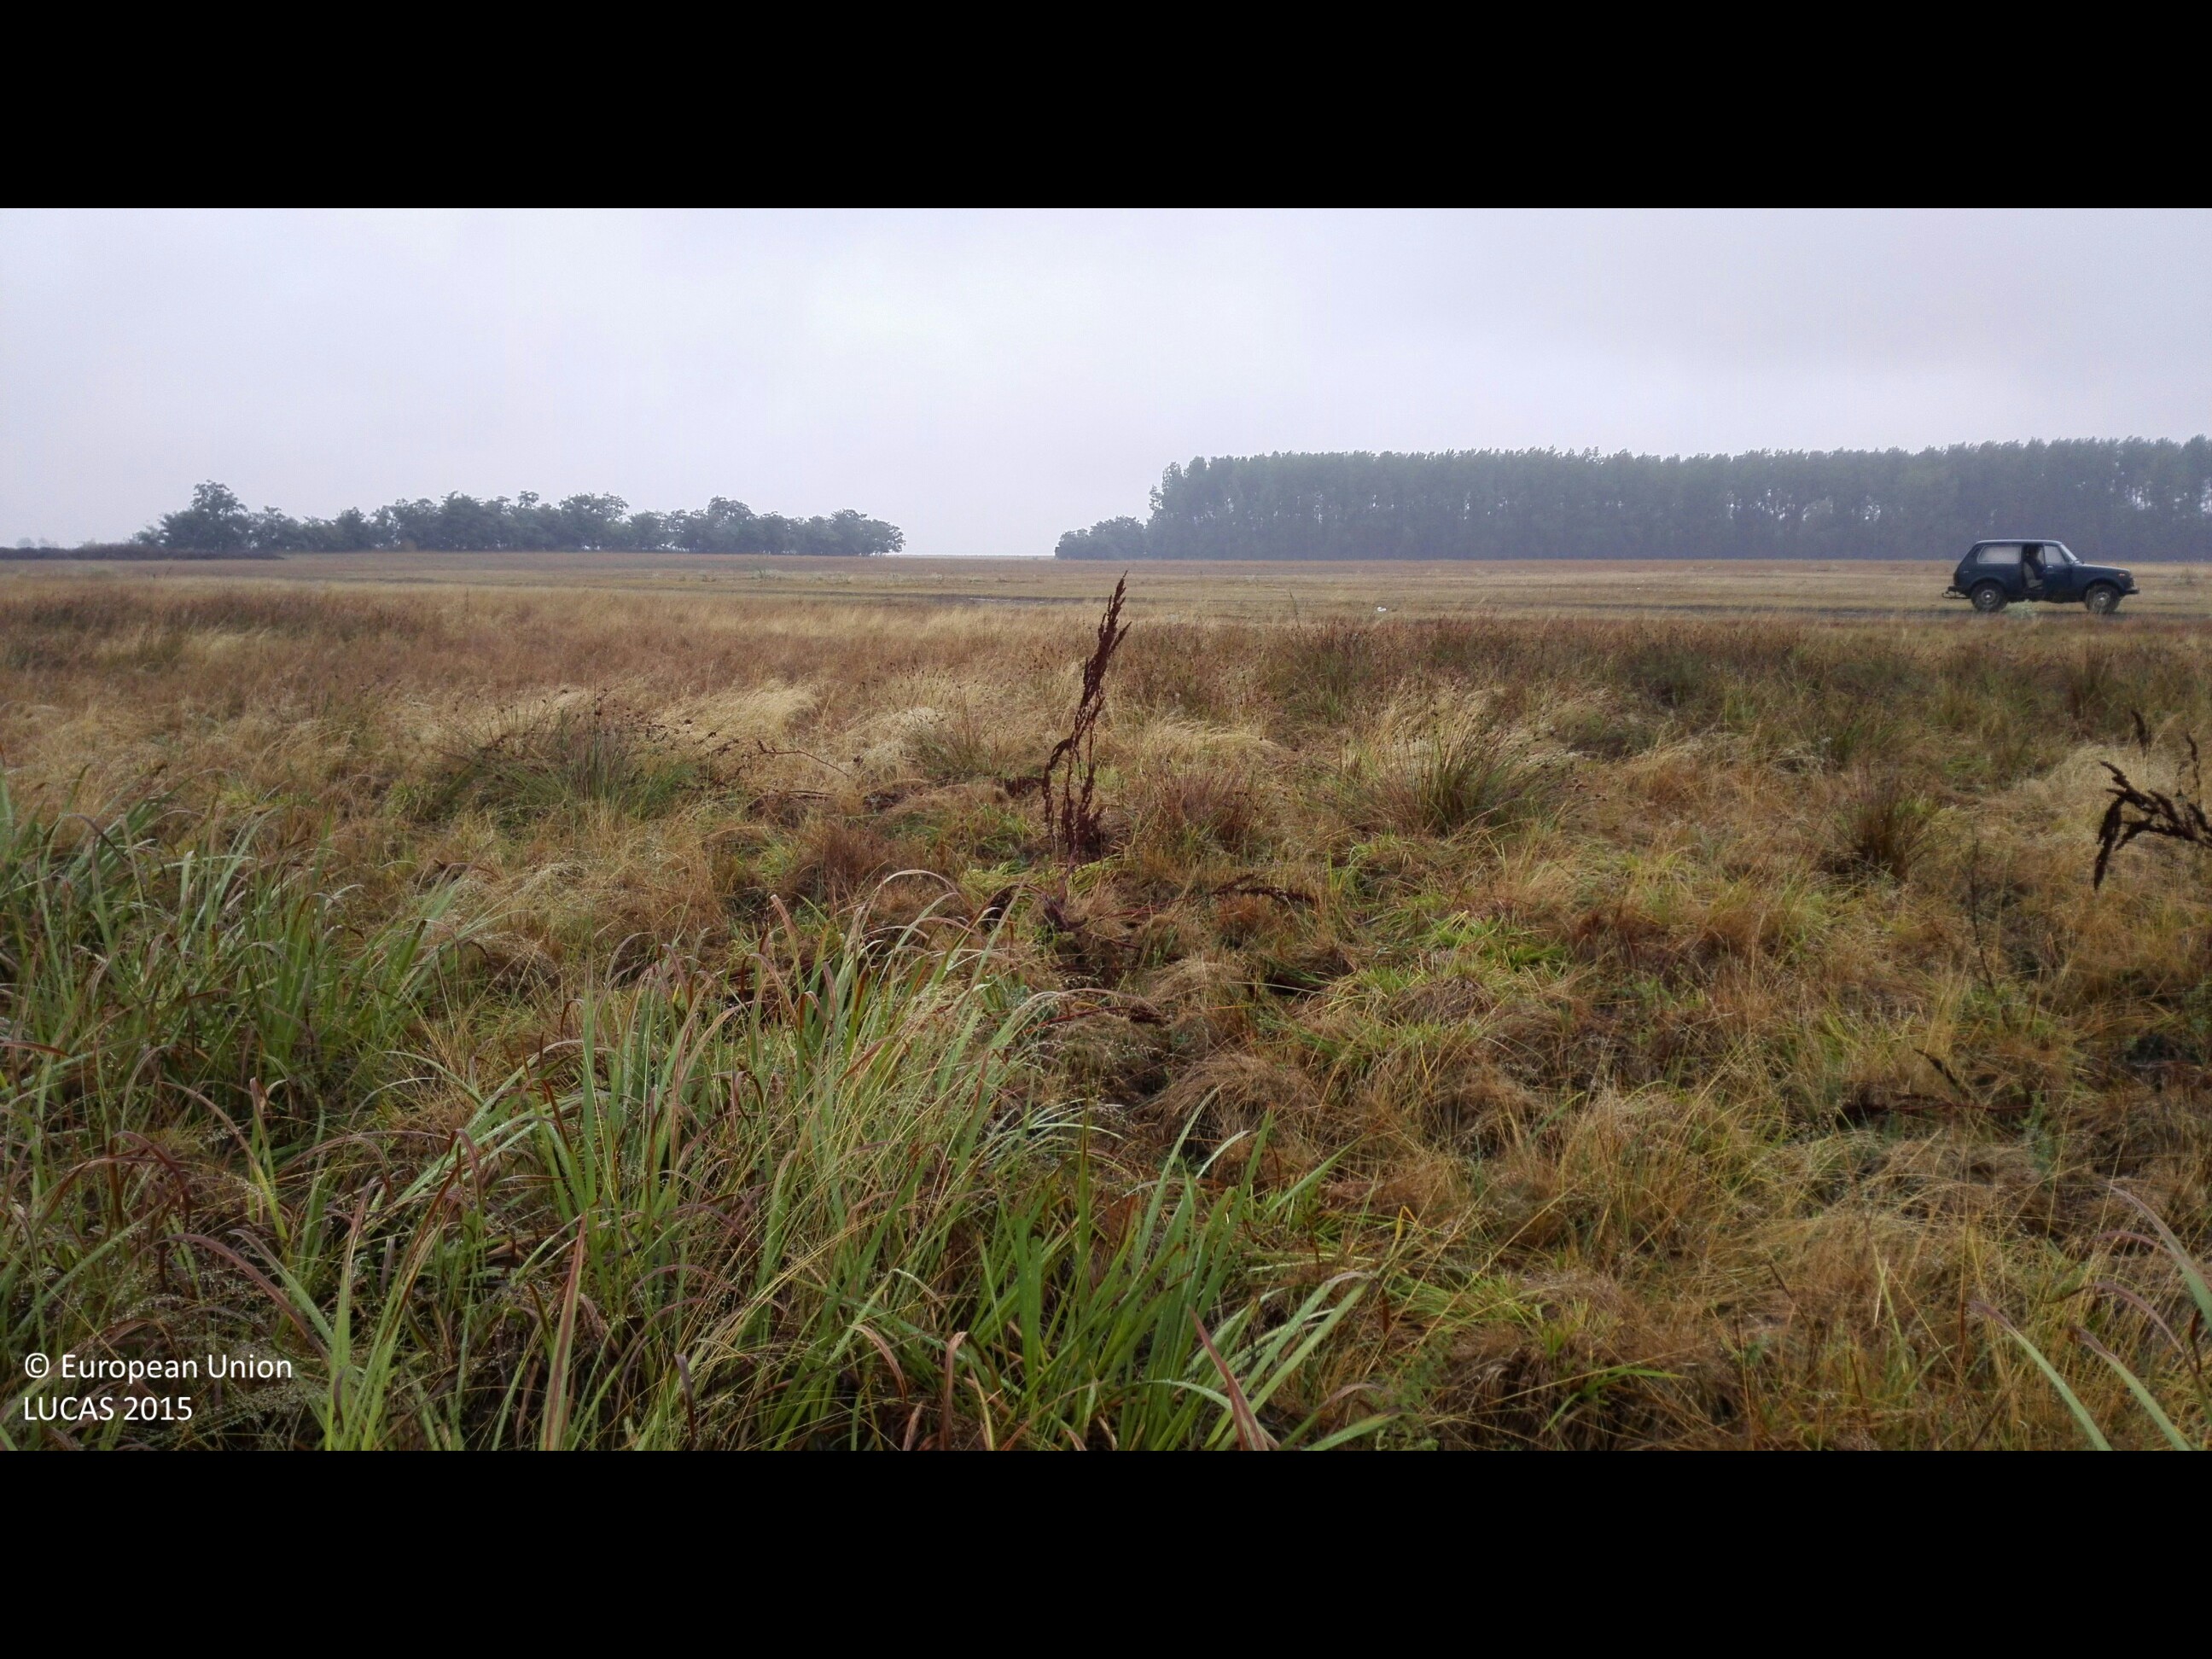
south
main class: Grassland
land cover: Spontaneously vegetated surfaces
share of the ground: > 75 %
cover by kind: herbaceous plants 100 %
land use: Agriculture (excluding fallow land and kitchen gardens)
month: August
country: HU
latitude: 47.2094
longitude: 21.5950
